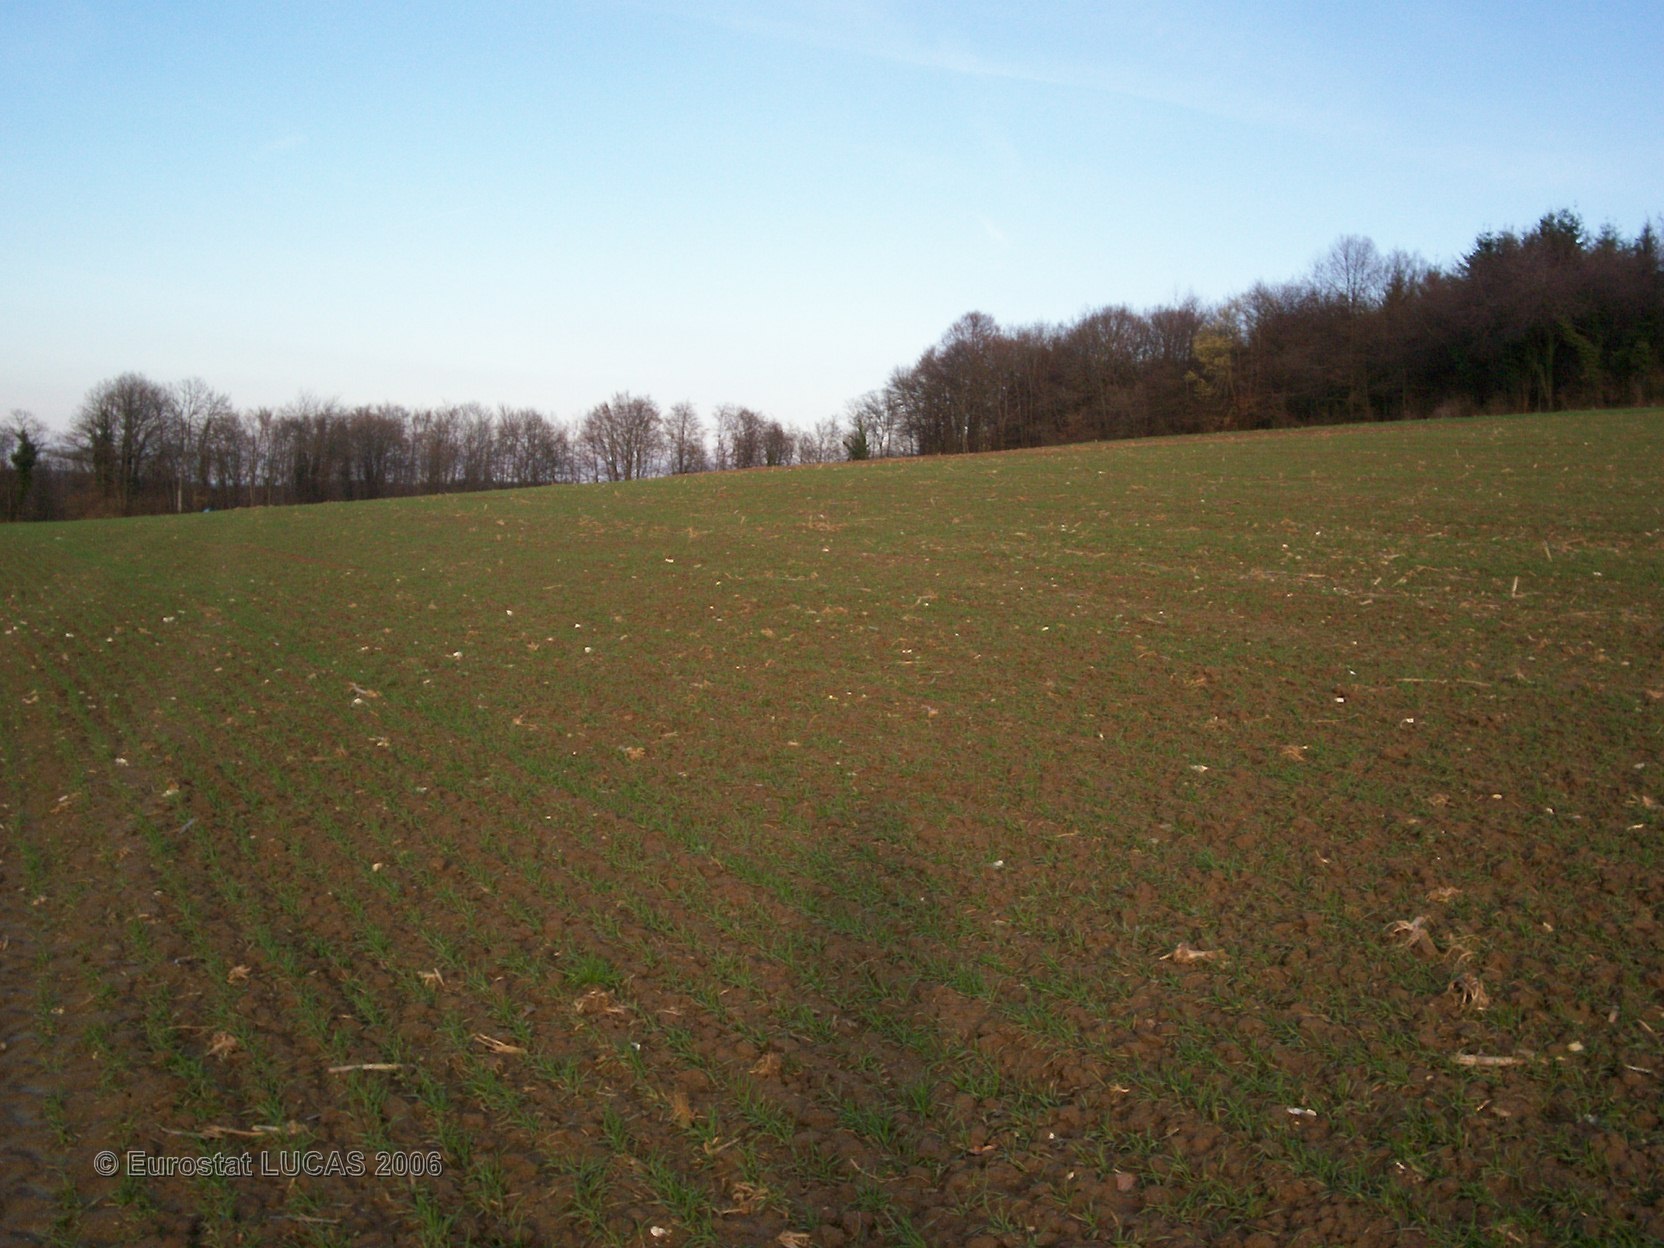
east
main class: Cropland
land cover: Common wheat
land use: Agriculture (excluding fallow land and kitchen gardens)
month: April
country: FR
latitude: 47.4621
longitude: 6.9905
